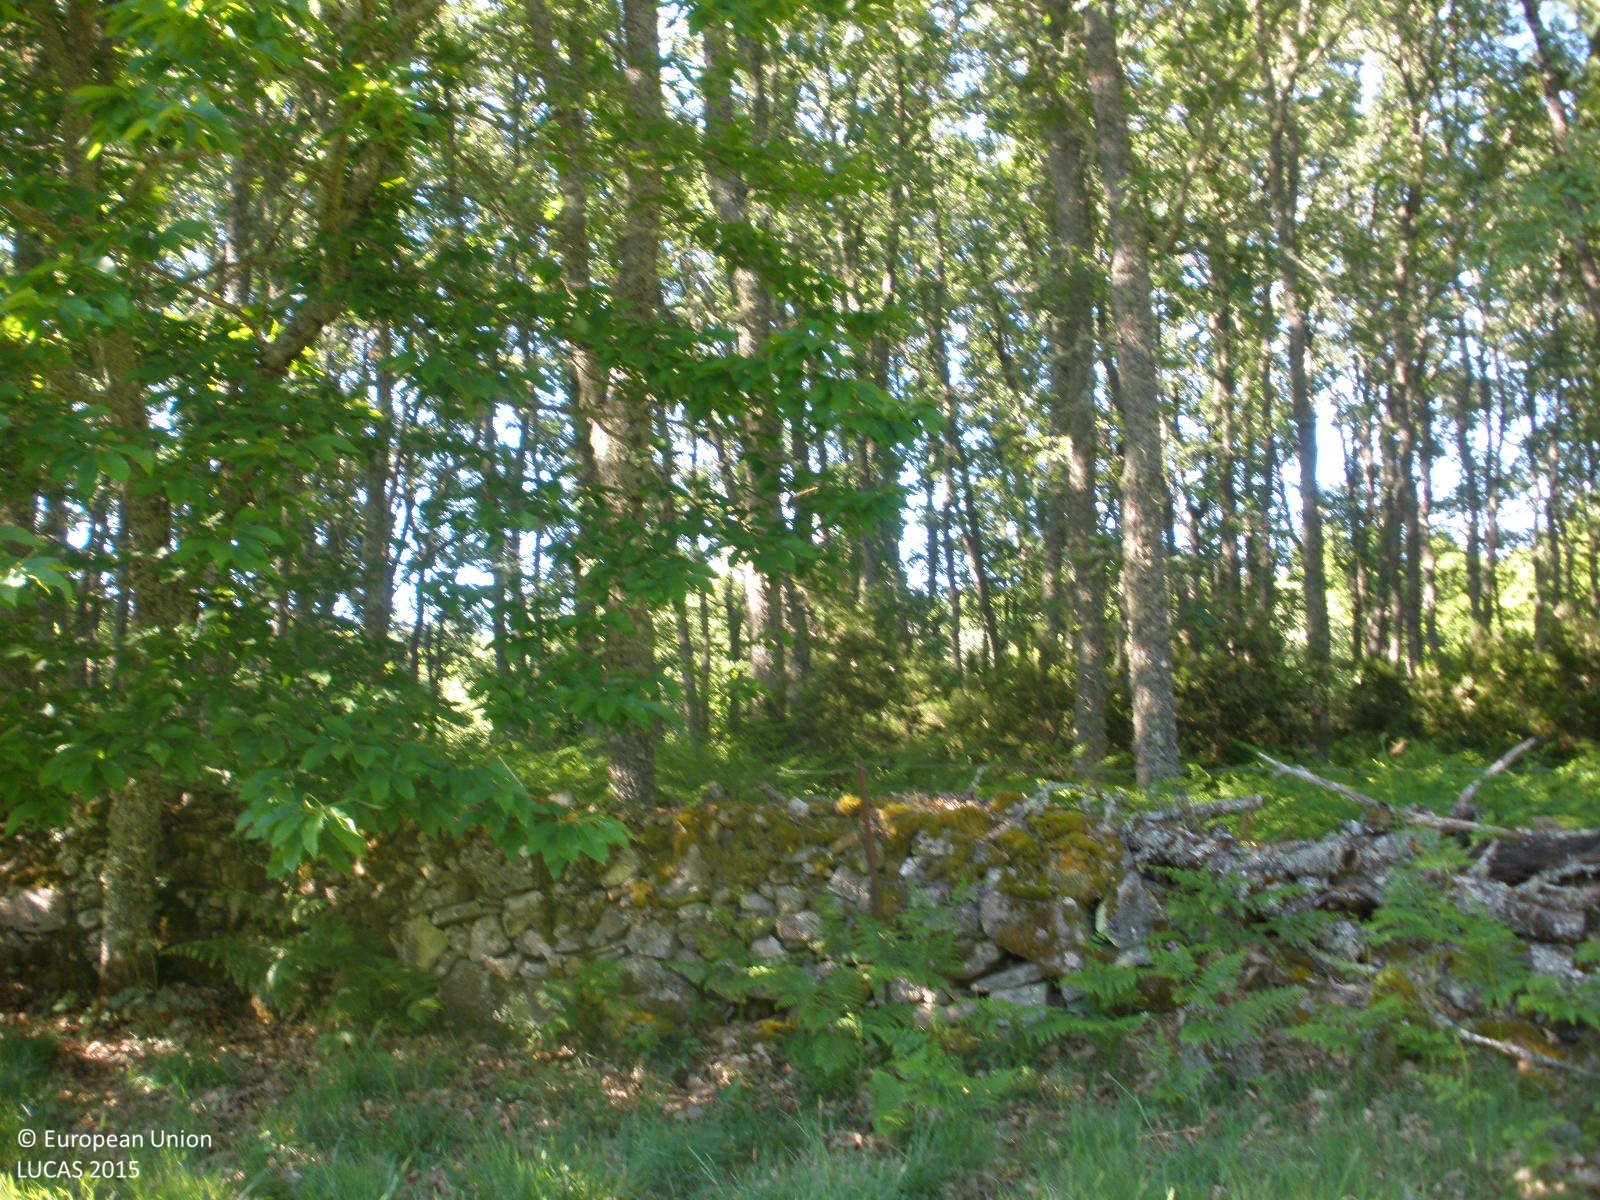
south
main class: Grassland
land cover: Grassland with sparse tree/shrub cover
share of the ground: > 75 %
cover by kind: herbaceous plants 95 %, broadleaved forest trees 5 %
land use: Agriculture (excluding fallow land and kitchen gardens)
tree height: > 5 m
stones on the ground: < 10 %
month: May
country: ES
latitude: 40.5213
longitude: -6.1449
